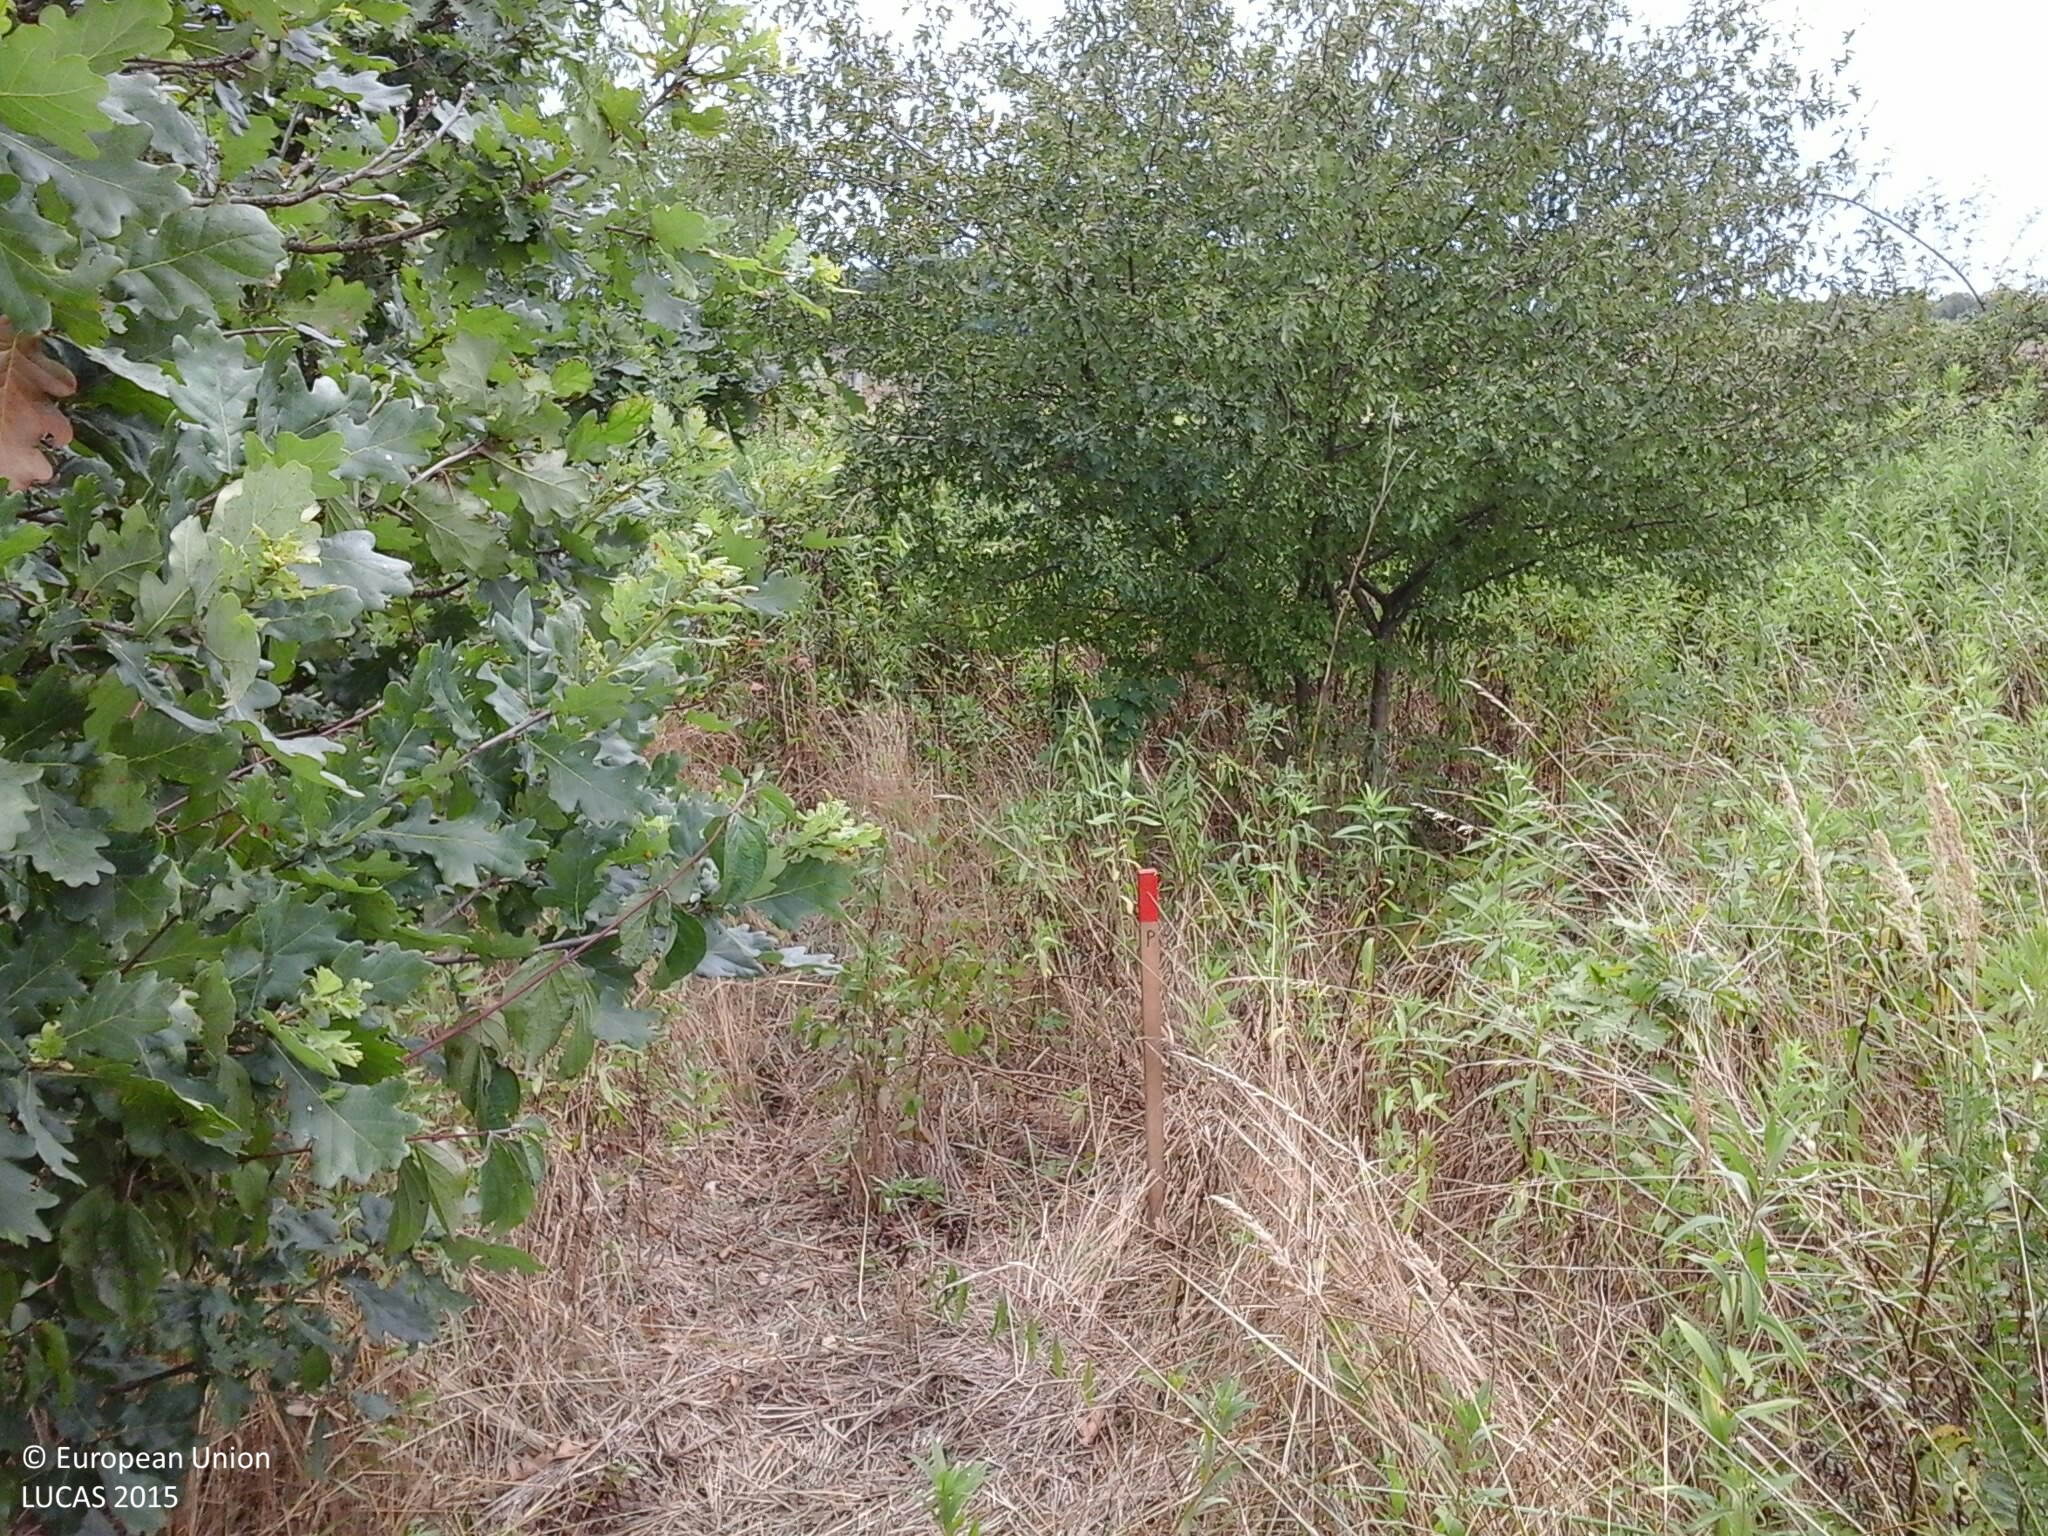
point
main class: Shrubland
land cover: Shrubland with sparse tree cover
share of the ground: > 75 %
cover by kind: shrubs 65 %, herbaceous plants 30 %, broadleaved forest trees 5 %
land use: Semi-natural and natural areas not in use
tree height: < 5 m
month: July
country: HU
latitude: 46.7117
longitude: 16.5293
